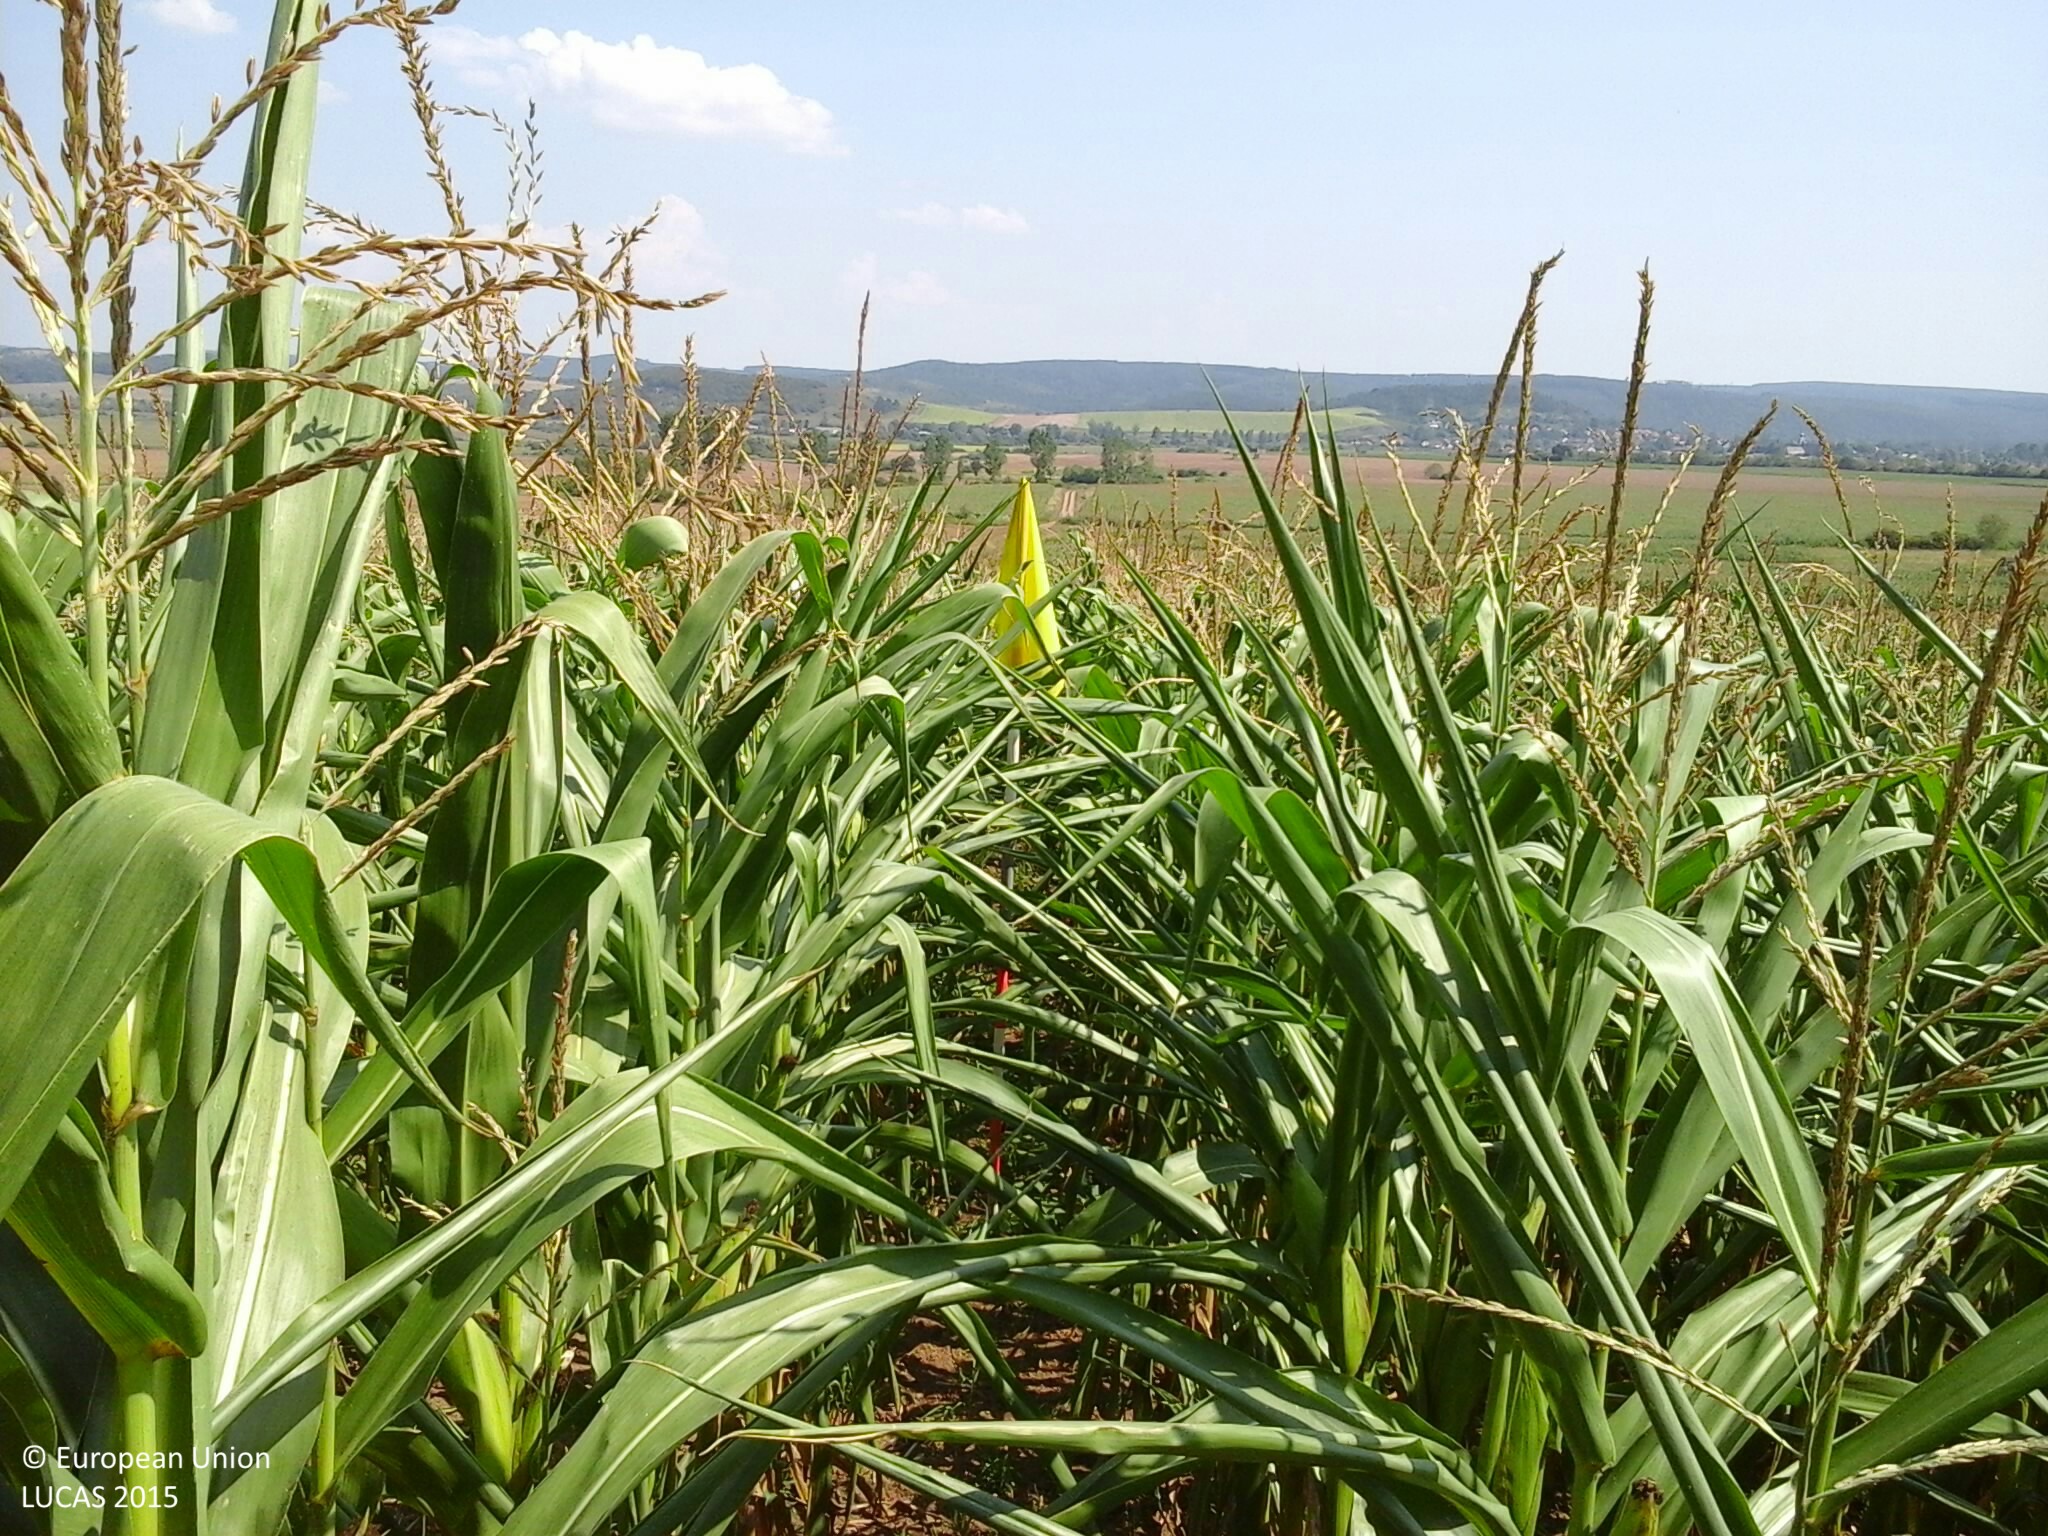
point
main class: Cropland
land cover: Maize
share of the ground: > 75 %
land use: Agriculture (excluding fallow land and kitchen gardens)
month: August
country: HU
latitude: 48.4272
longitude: 20.6997
